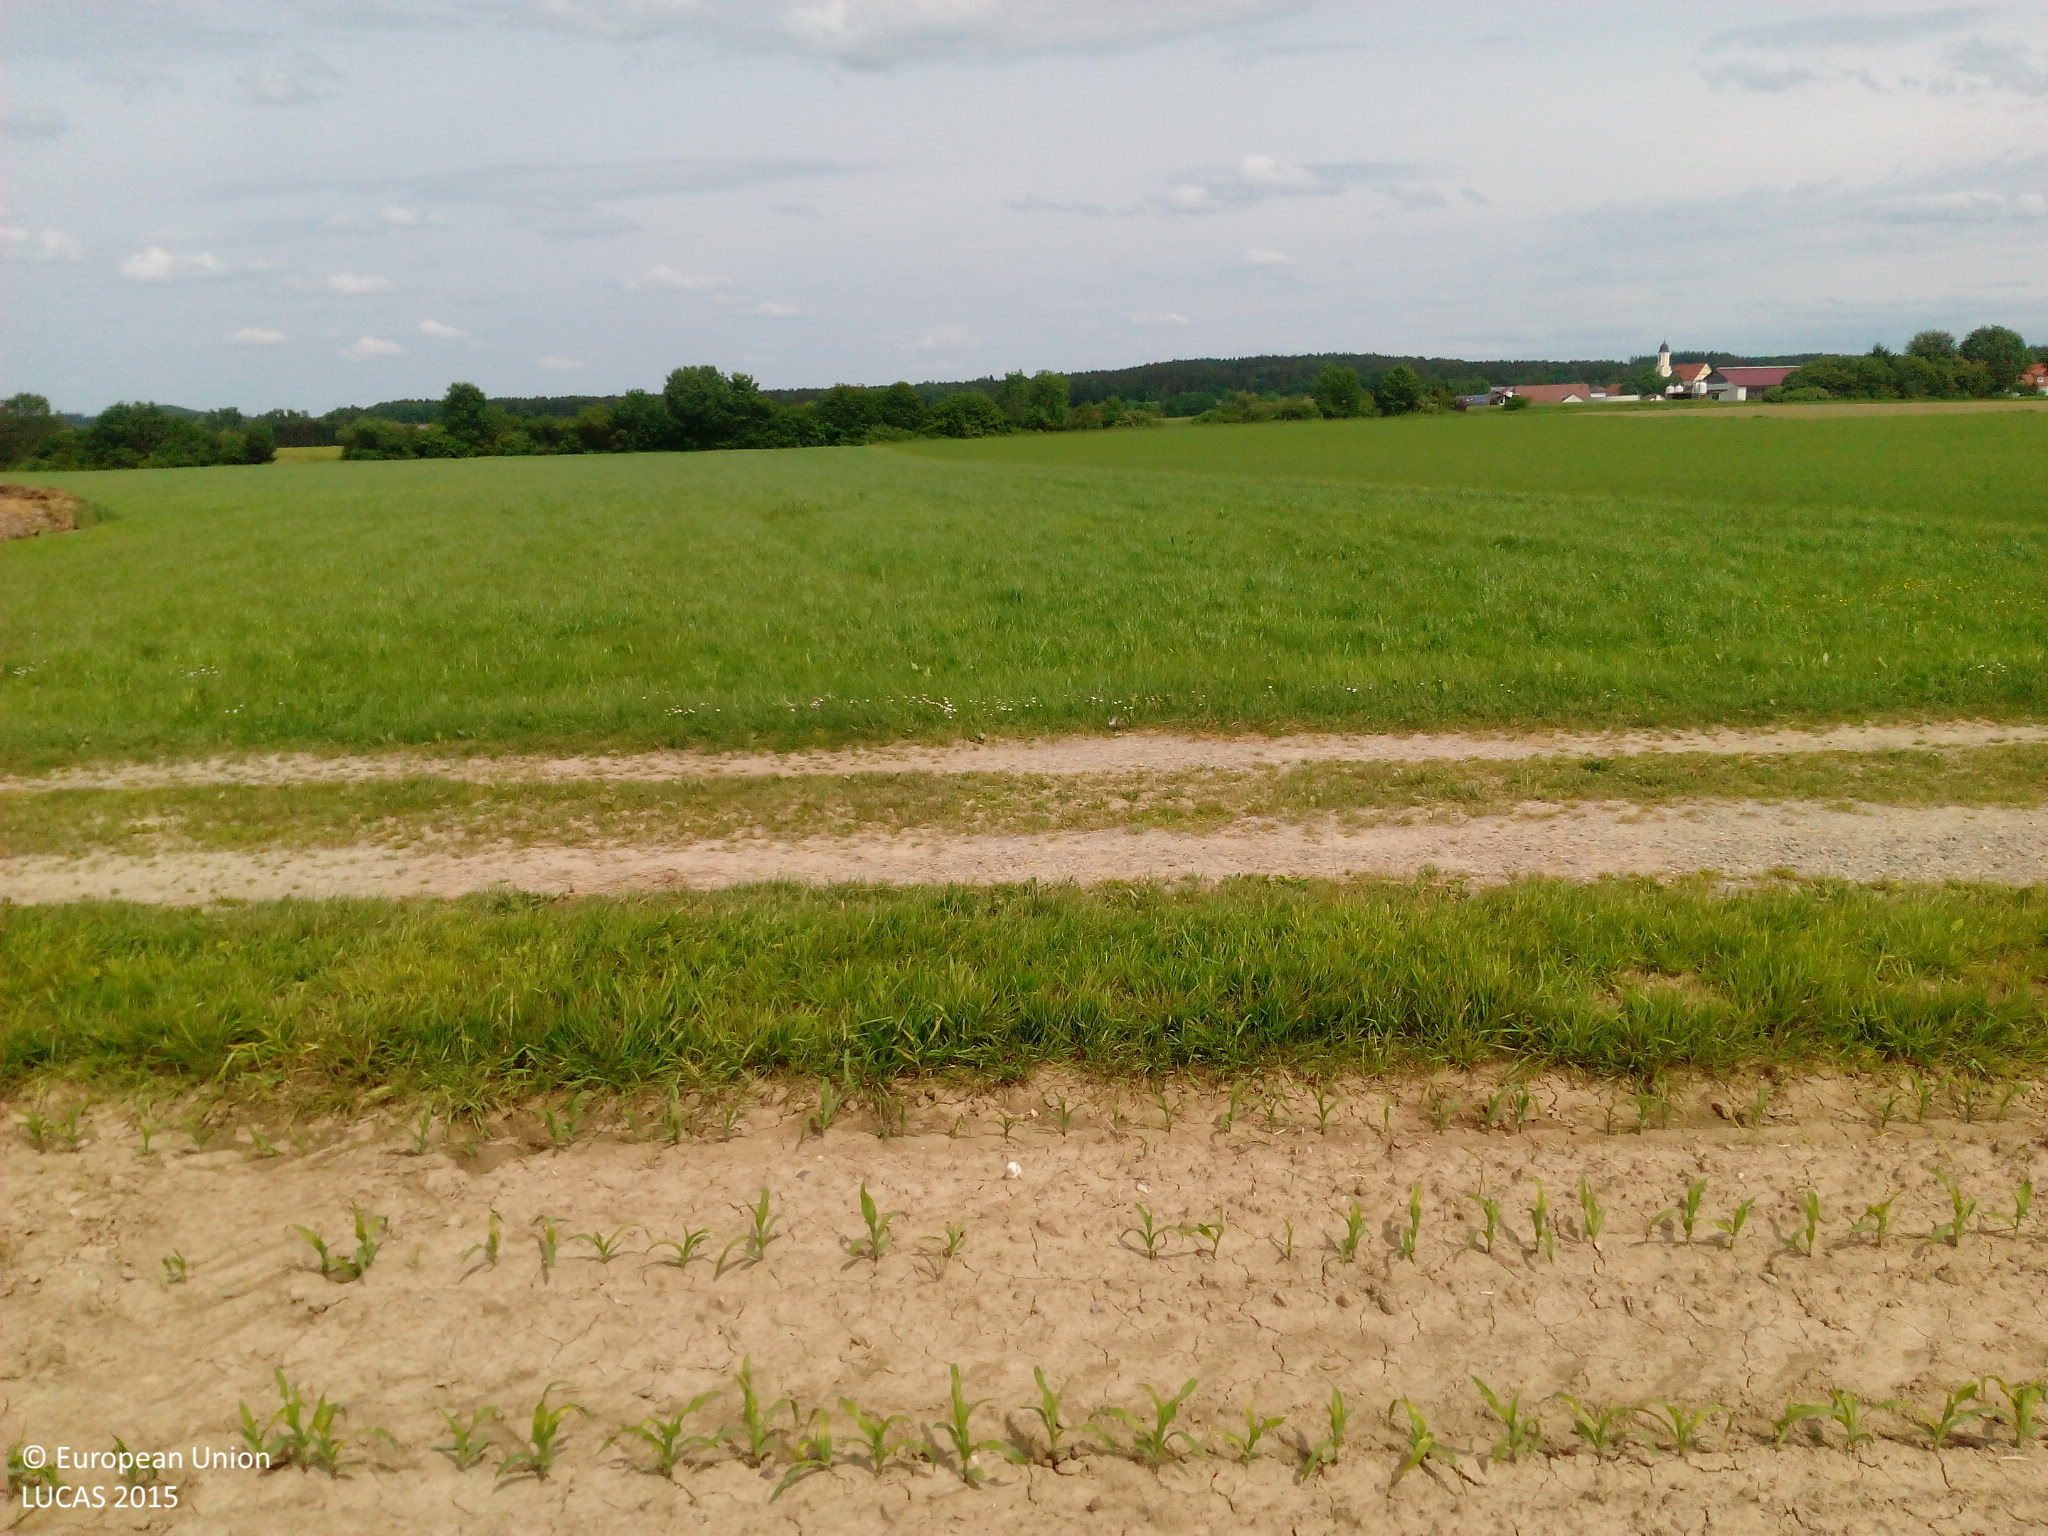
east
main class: Cropland
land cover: Maize
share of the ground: < 10 %
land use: Agriculture (excluding fallow land and kitchen gardens)
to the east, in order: Maize; Grass margins; Tracks; Grassland without tree/shrub cover; Temporary grasslands; Grass margins; Tracks; Abandoned hedges; Grass margins; Rape and turnip rape
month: May
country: DE
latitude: 48.0073
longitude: 10.2545
